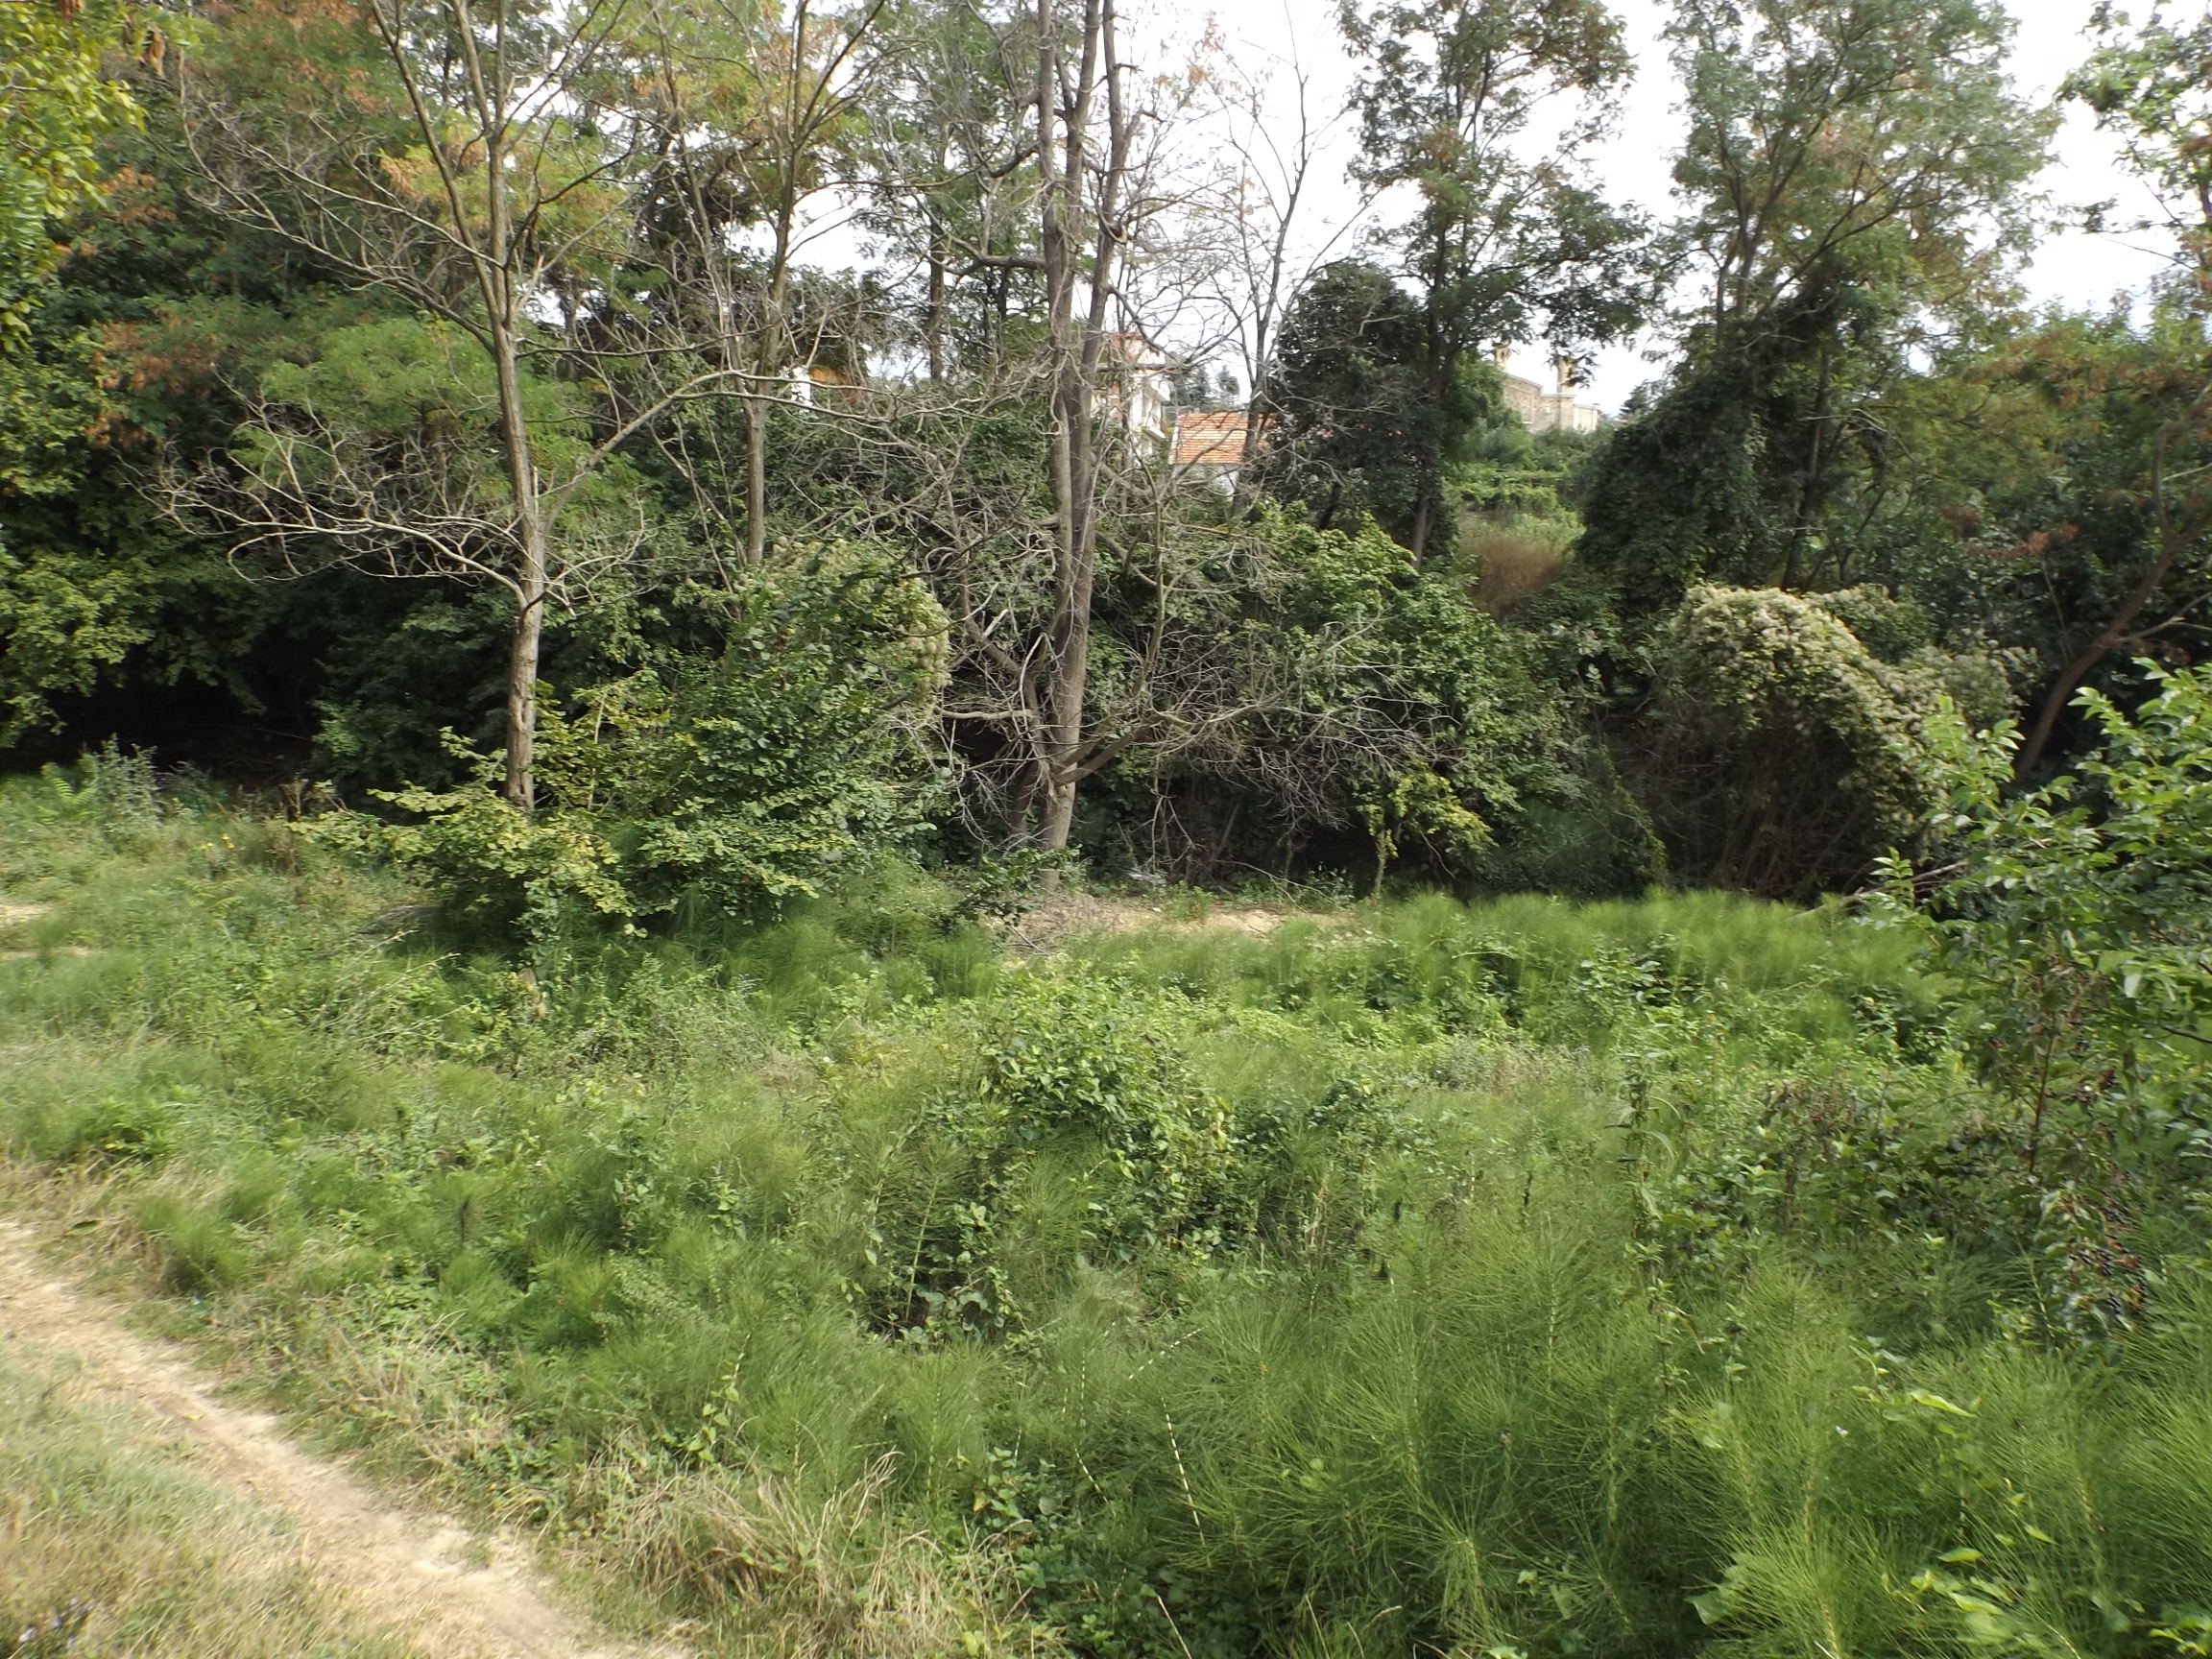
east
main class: Woodland
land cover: Broadleaved woodland
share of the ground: 50 - 75 %
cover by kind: broadleaved forest trees 65 %, herbaceous plants 25 %, shrubs 10 %
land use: Residential
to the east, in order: Broadleaved woodland; Ditches and canals; Broadleaved woodland; Paved roads, cycling and walking lanes; Broadleaved woodland; Artificial constructions in urban areas
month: August
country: BG
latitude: 43.2336
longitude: 27.9330
